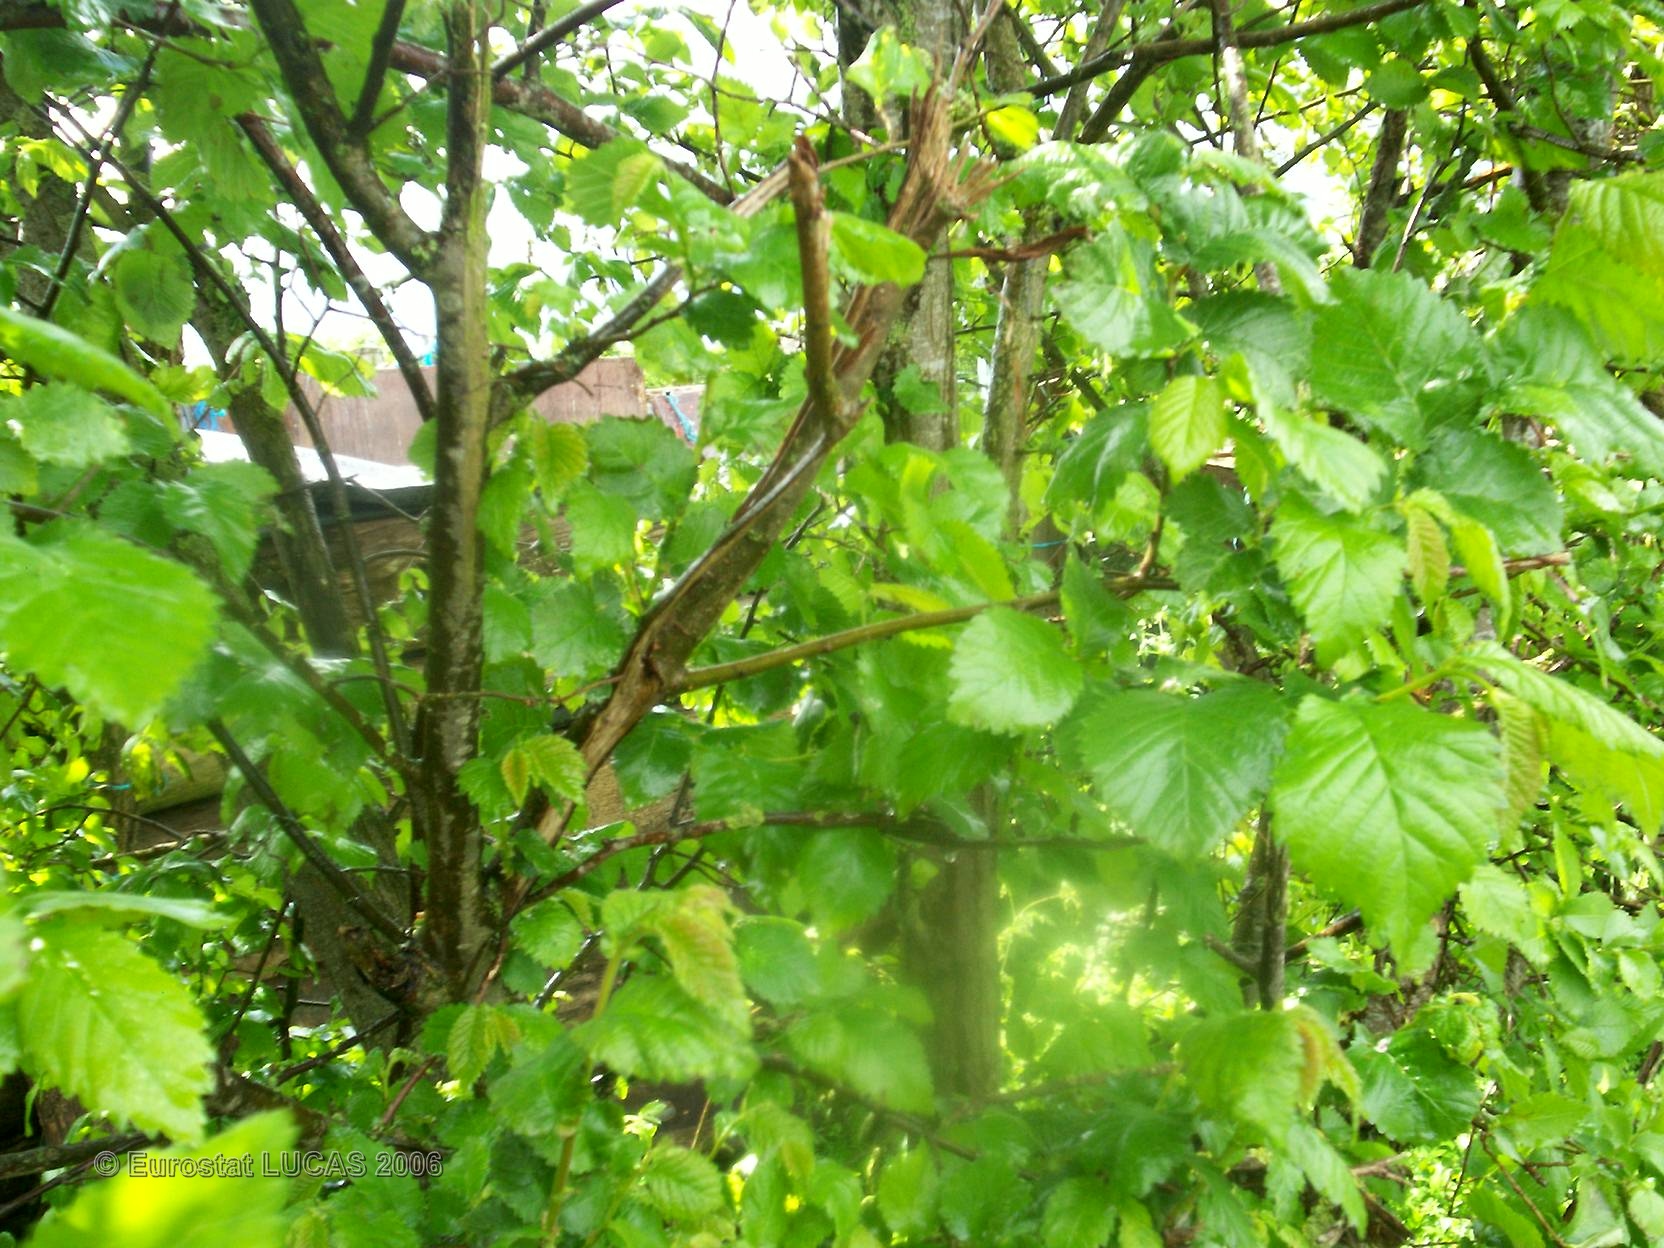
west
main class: Cropland
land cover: Common wheat
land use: Agriculture (excluding fallow land and kitchen gardens)
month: May
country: FR
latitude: 48.8972
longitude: -0.1397
